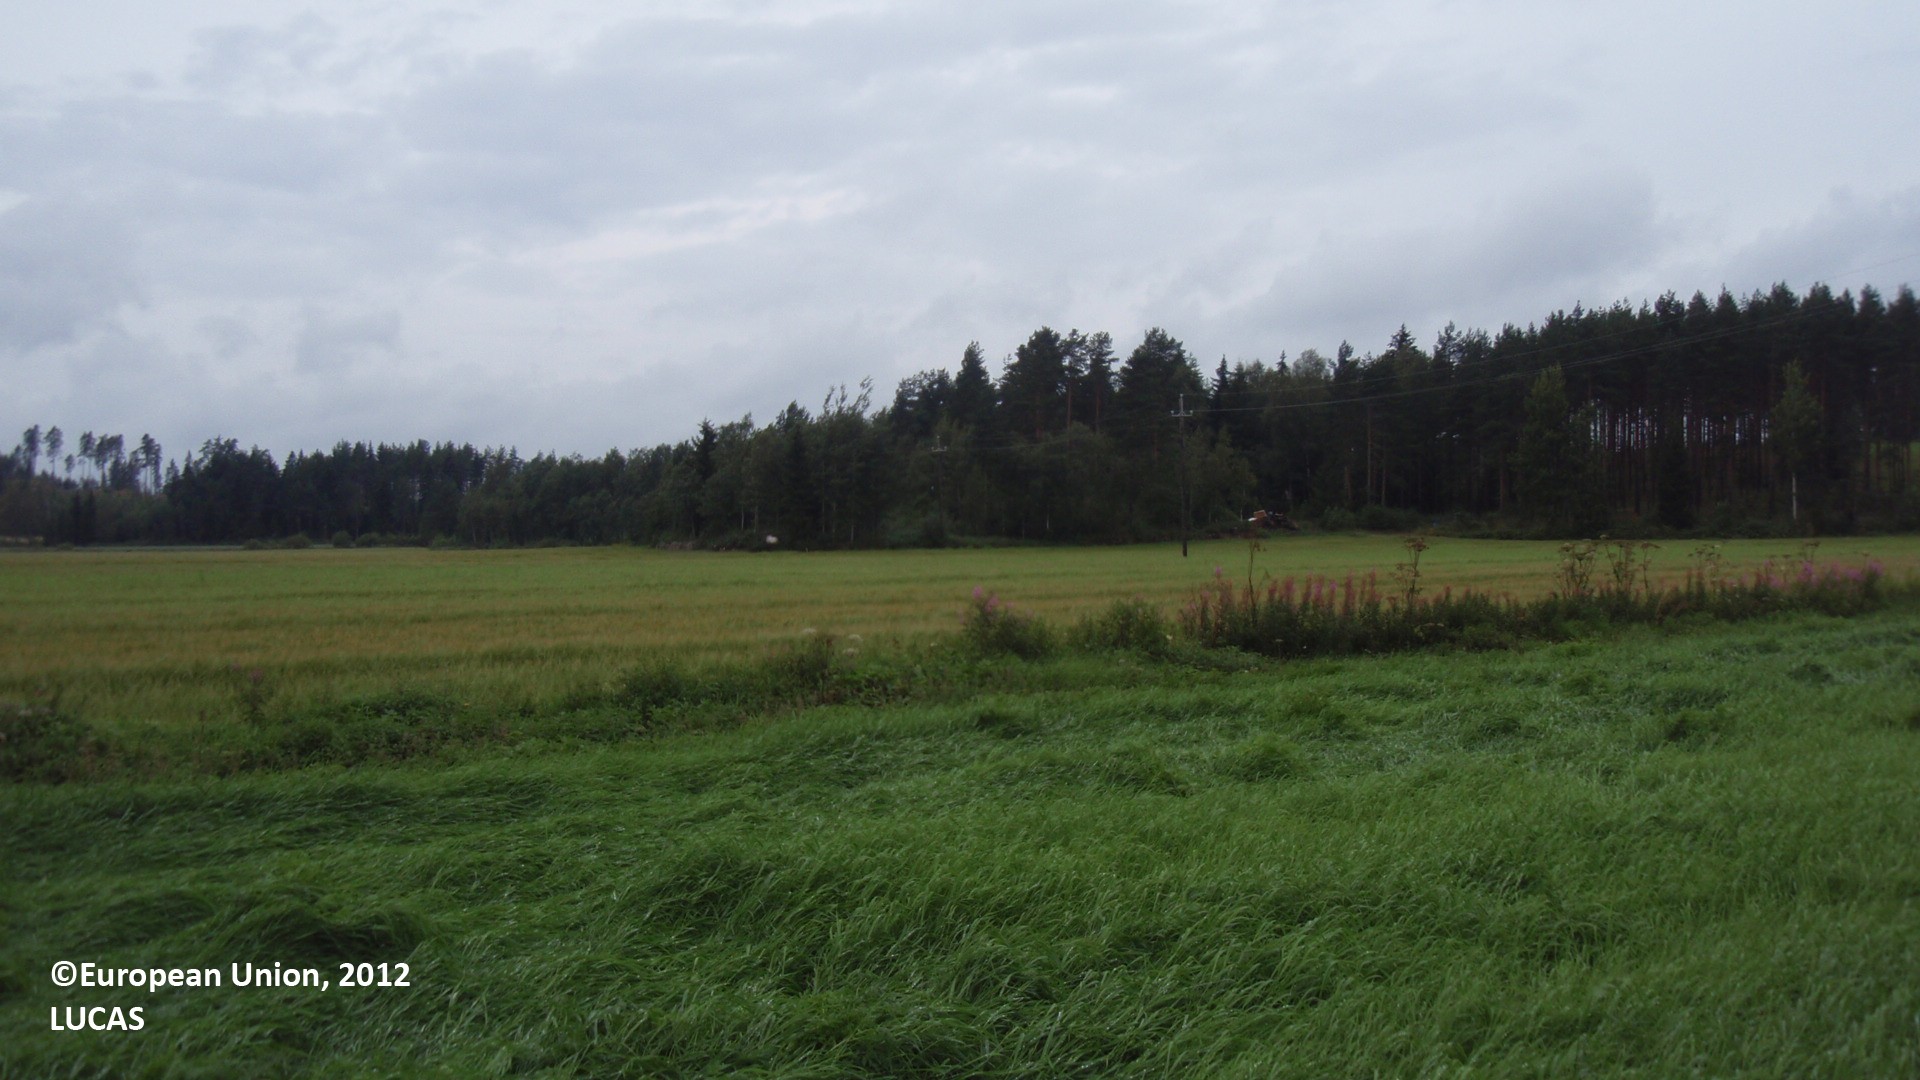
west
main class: Cropland
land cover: Temporary grasslands
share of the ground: > 75 %
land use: Agriculture (excluding fallow land and kitchen gardens)
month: August
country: FI
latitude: 61.0854
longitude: 27.0963
